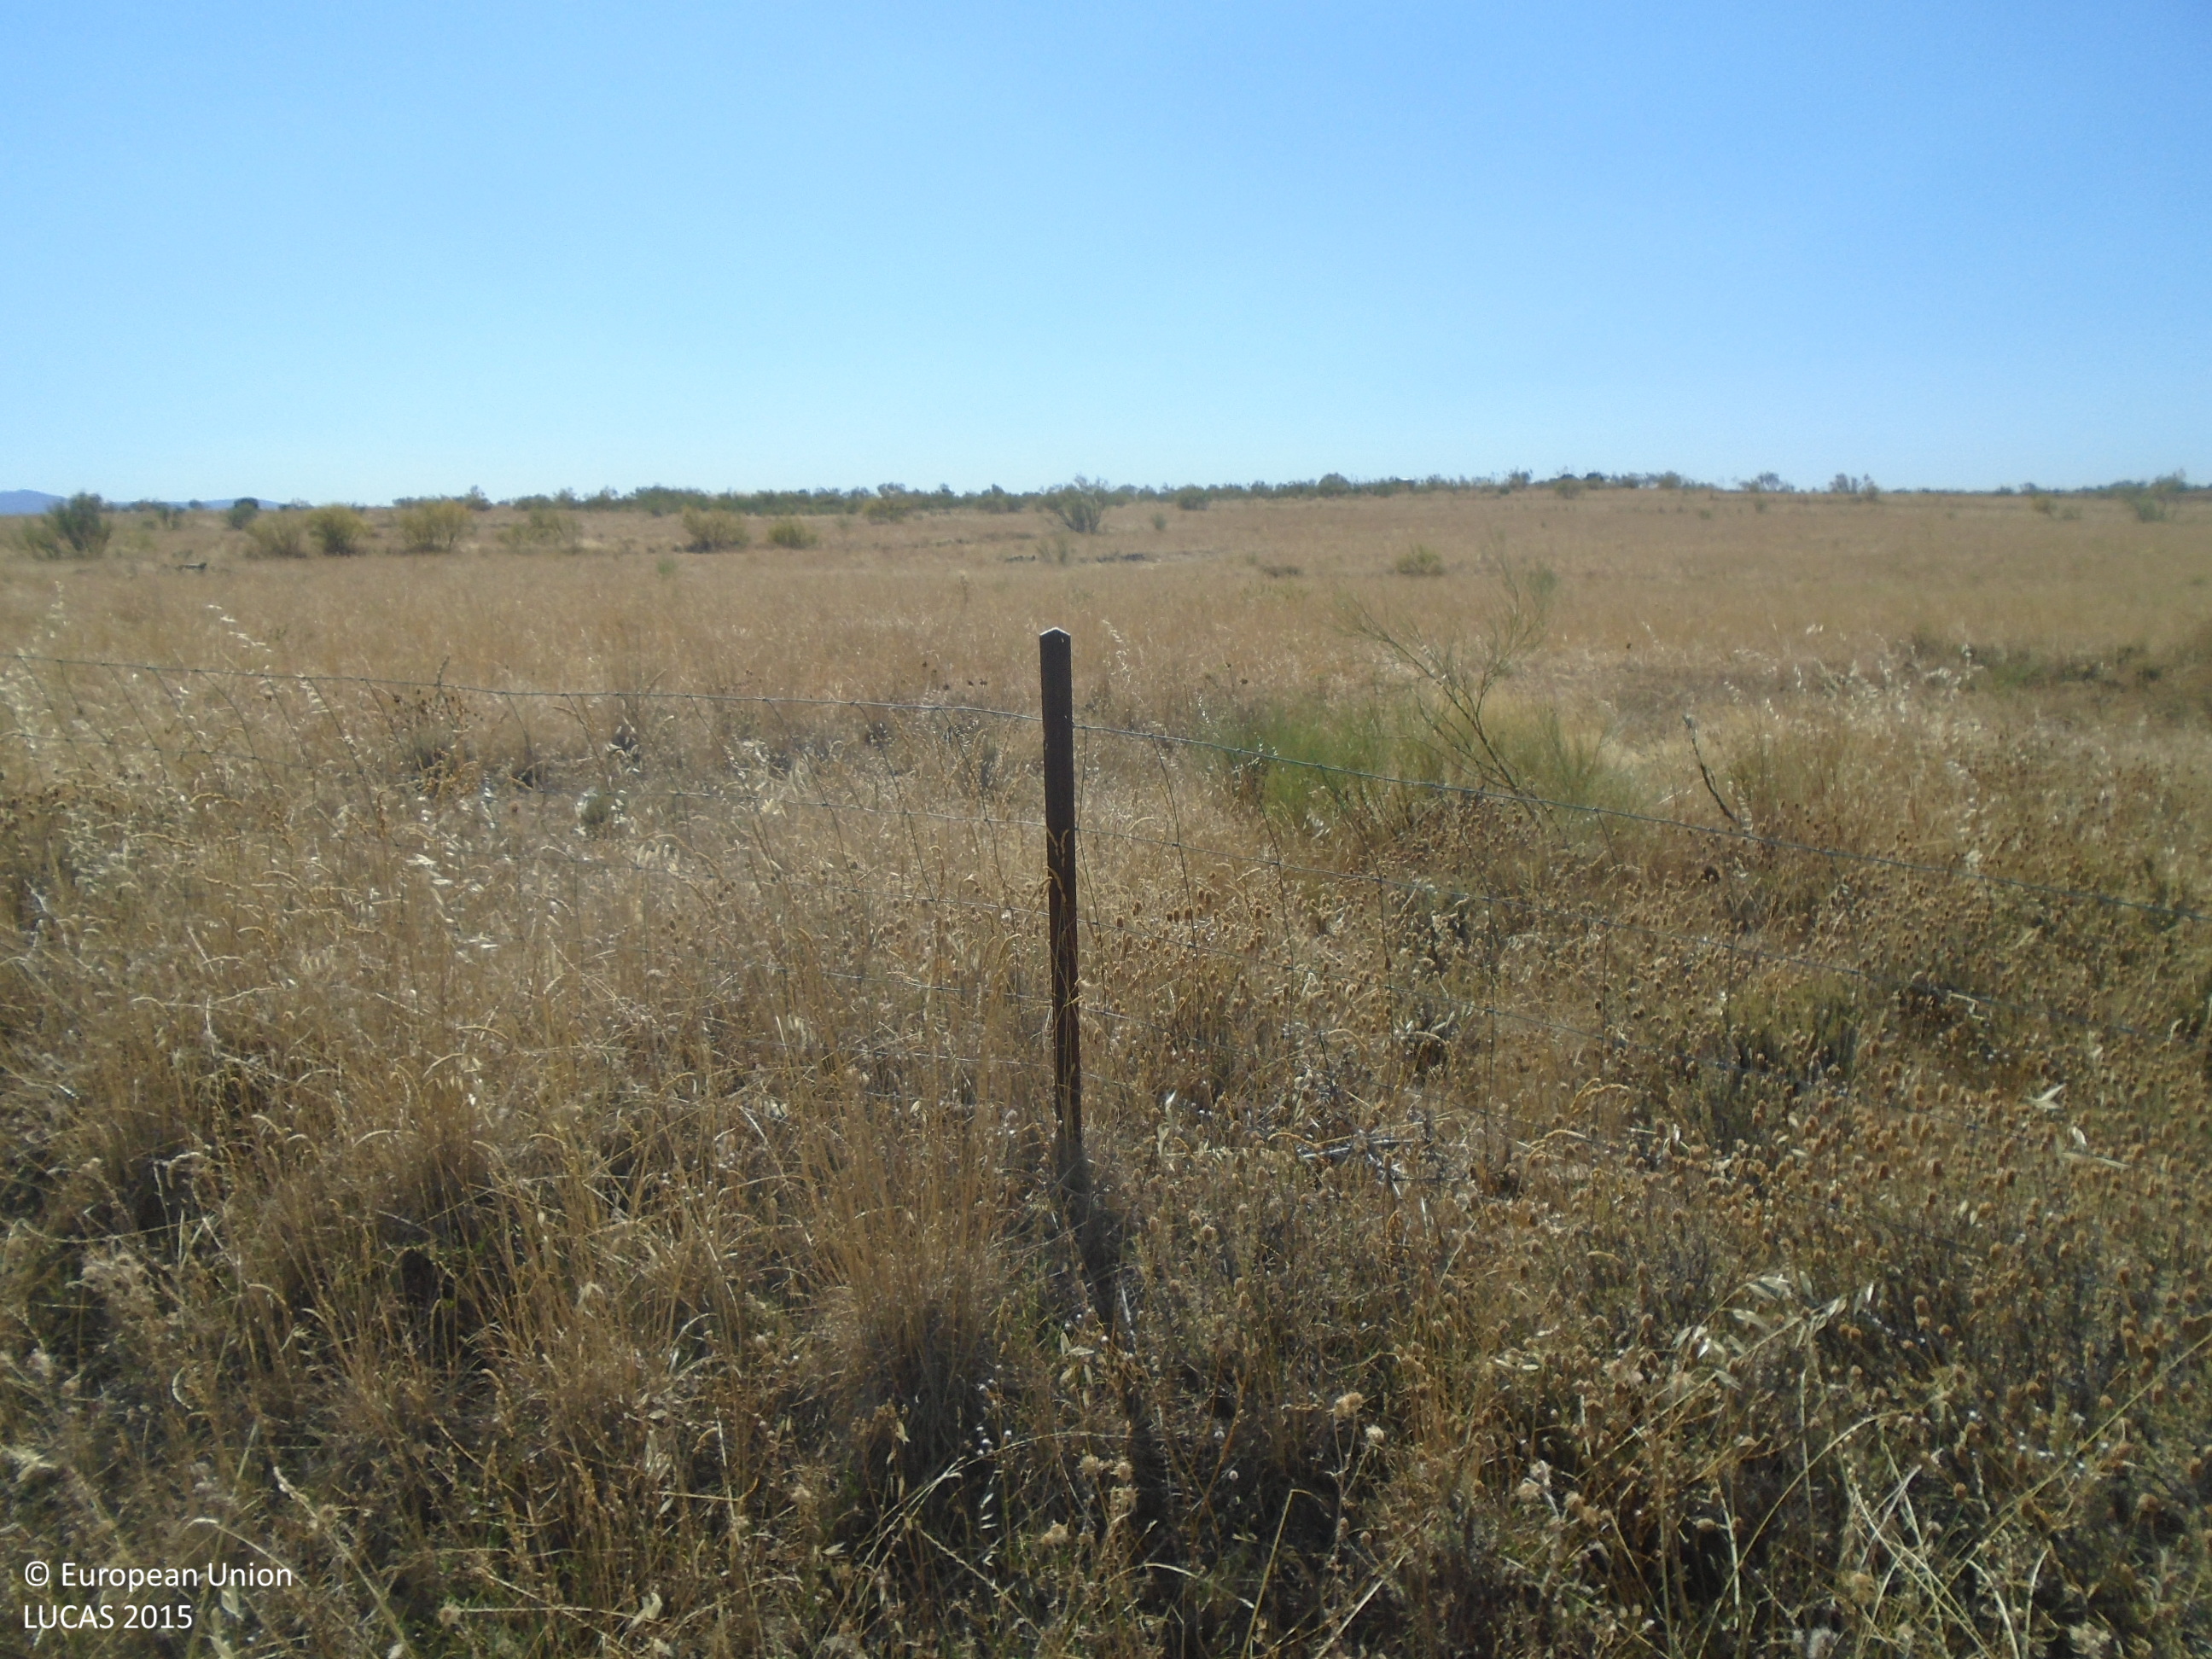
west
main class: Grassland
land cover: Spontaneously vegetated surfaces
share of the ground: > 75 %
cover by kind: herbaceous plants 100 %
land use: Abandoned areas
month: July
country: ES
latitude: 39.6649
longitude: -5.0725
